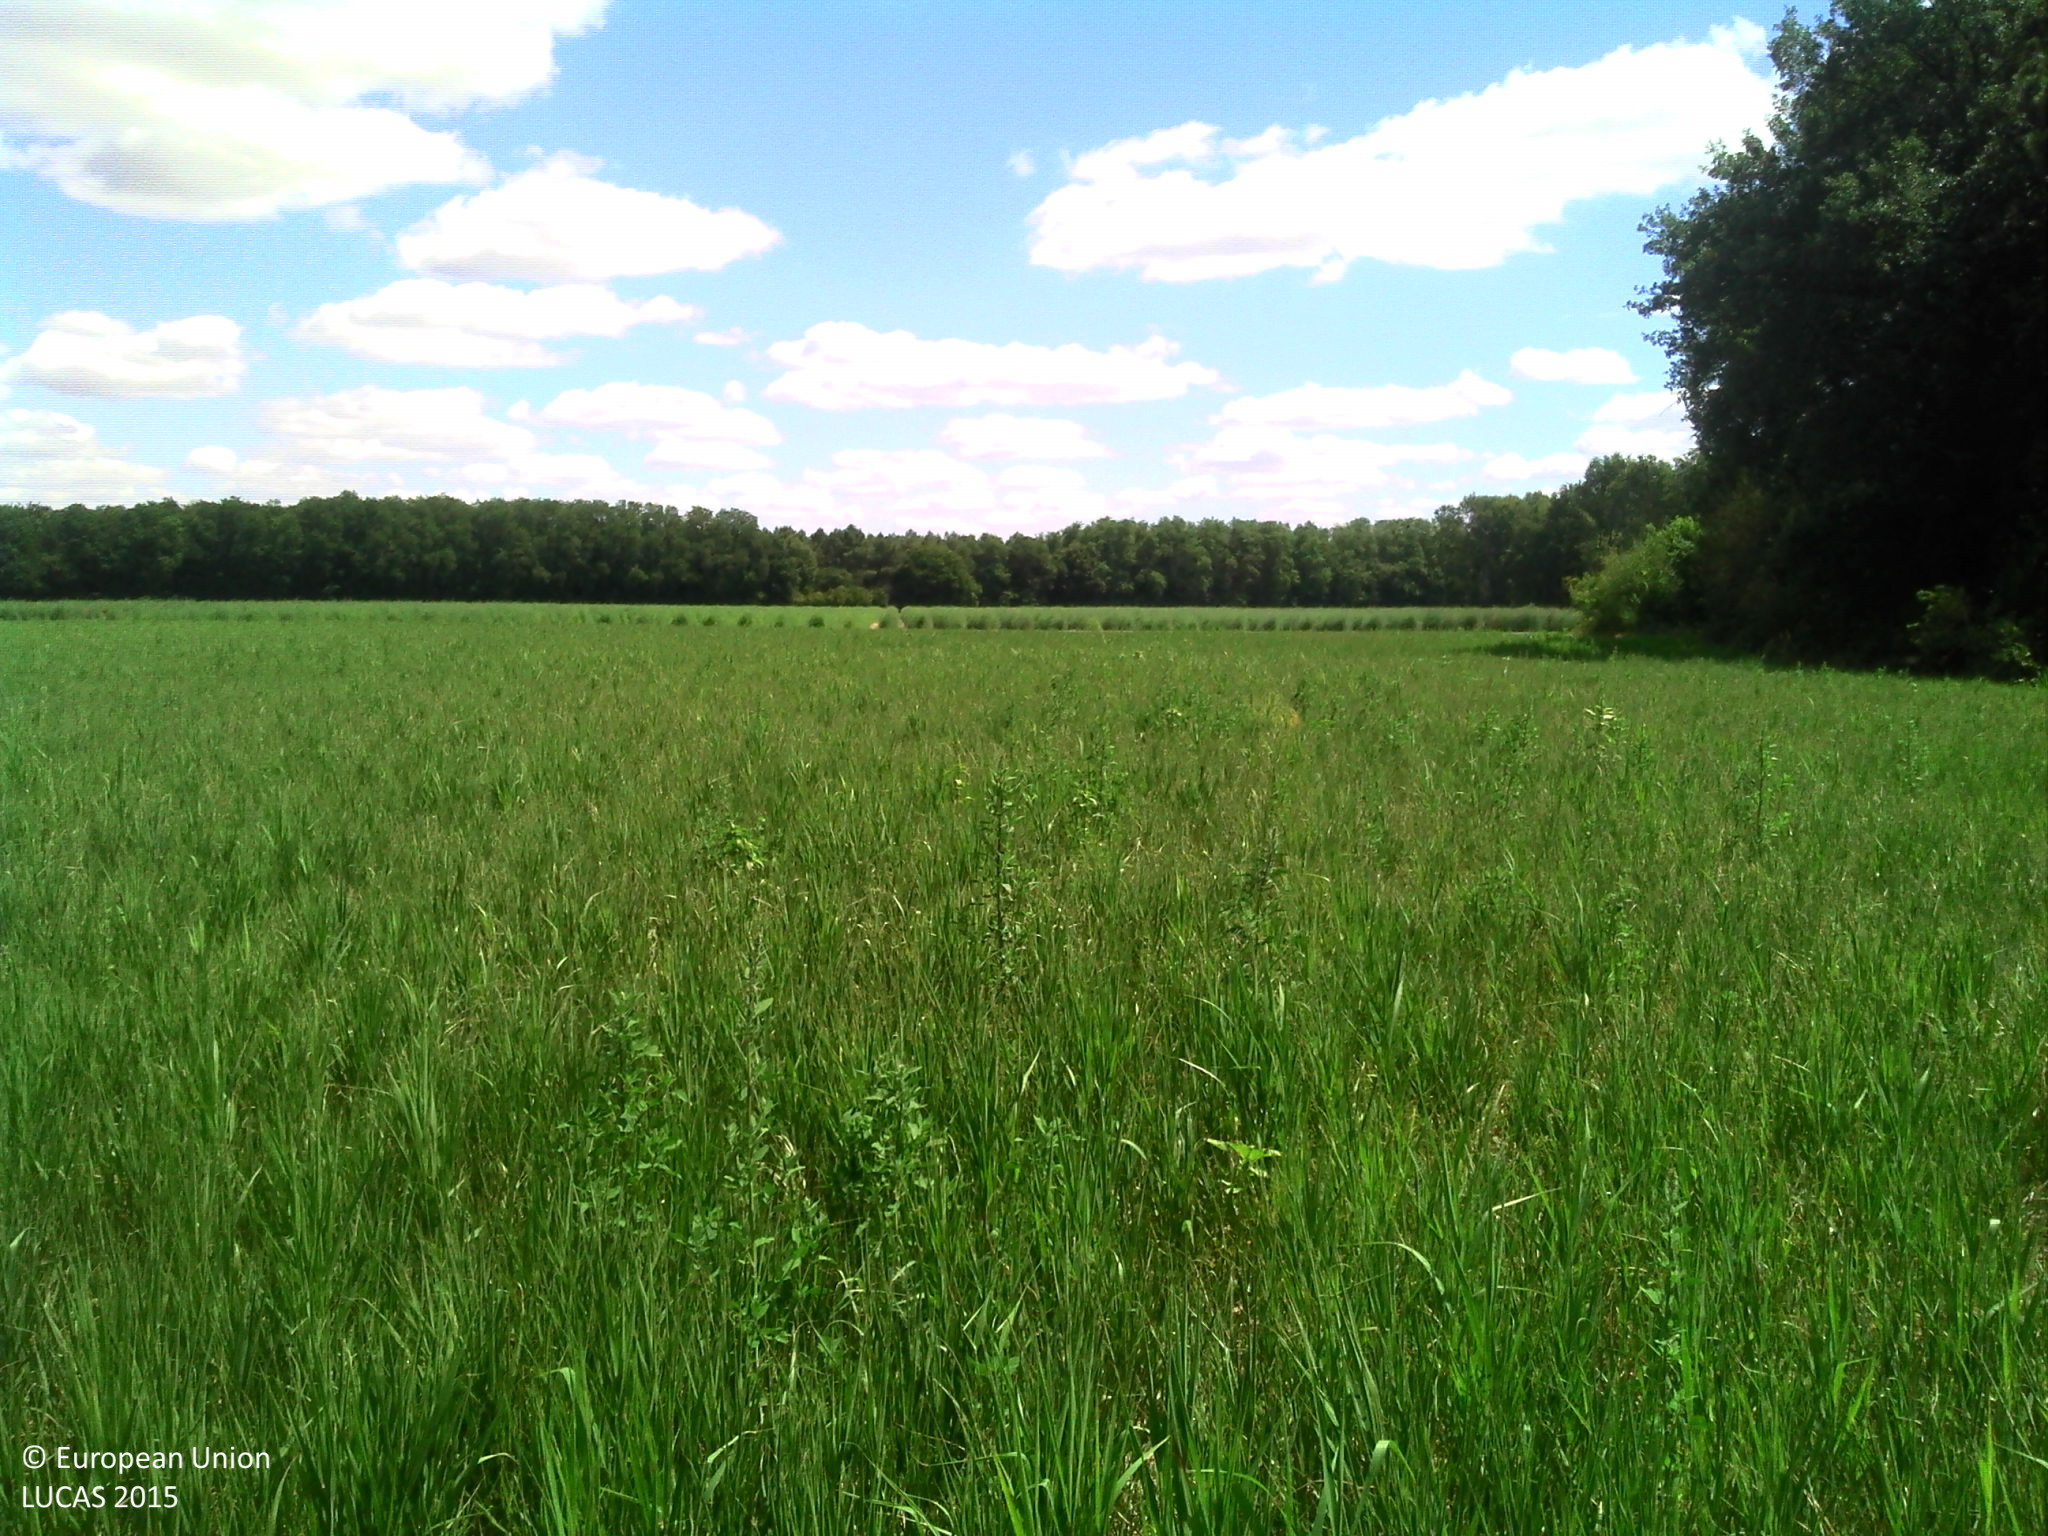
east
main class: Cropland
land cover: Temporary grasslands
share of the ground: > 75 %
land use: Agriculture (excluding fallow land and kitchen gardens)
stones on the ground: < 10 %
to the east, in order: Temporary grasslands; Grass margins; Paved roads, cycling and walking lanes; Grass margins; Other bare soil; Floriculture and ornamental plants
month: July
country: FR
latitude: 47.0412
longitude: 0.3848
